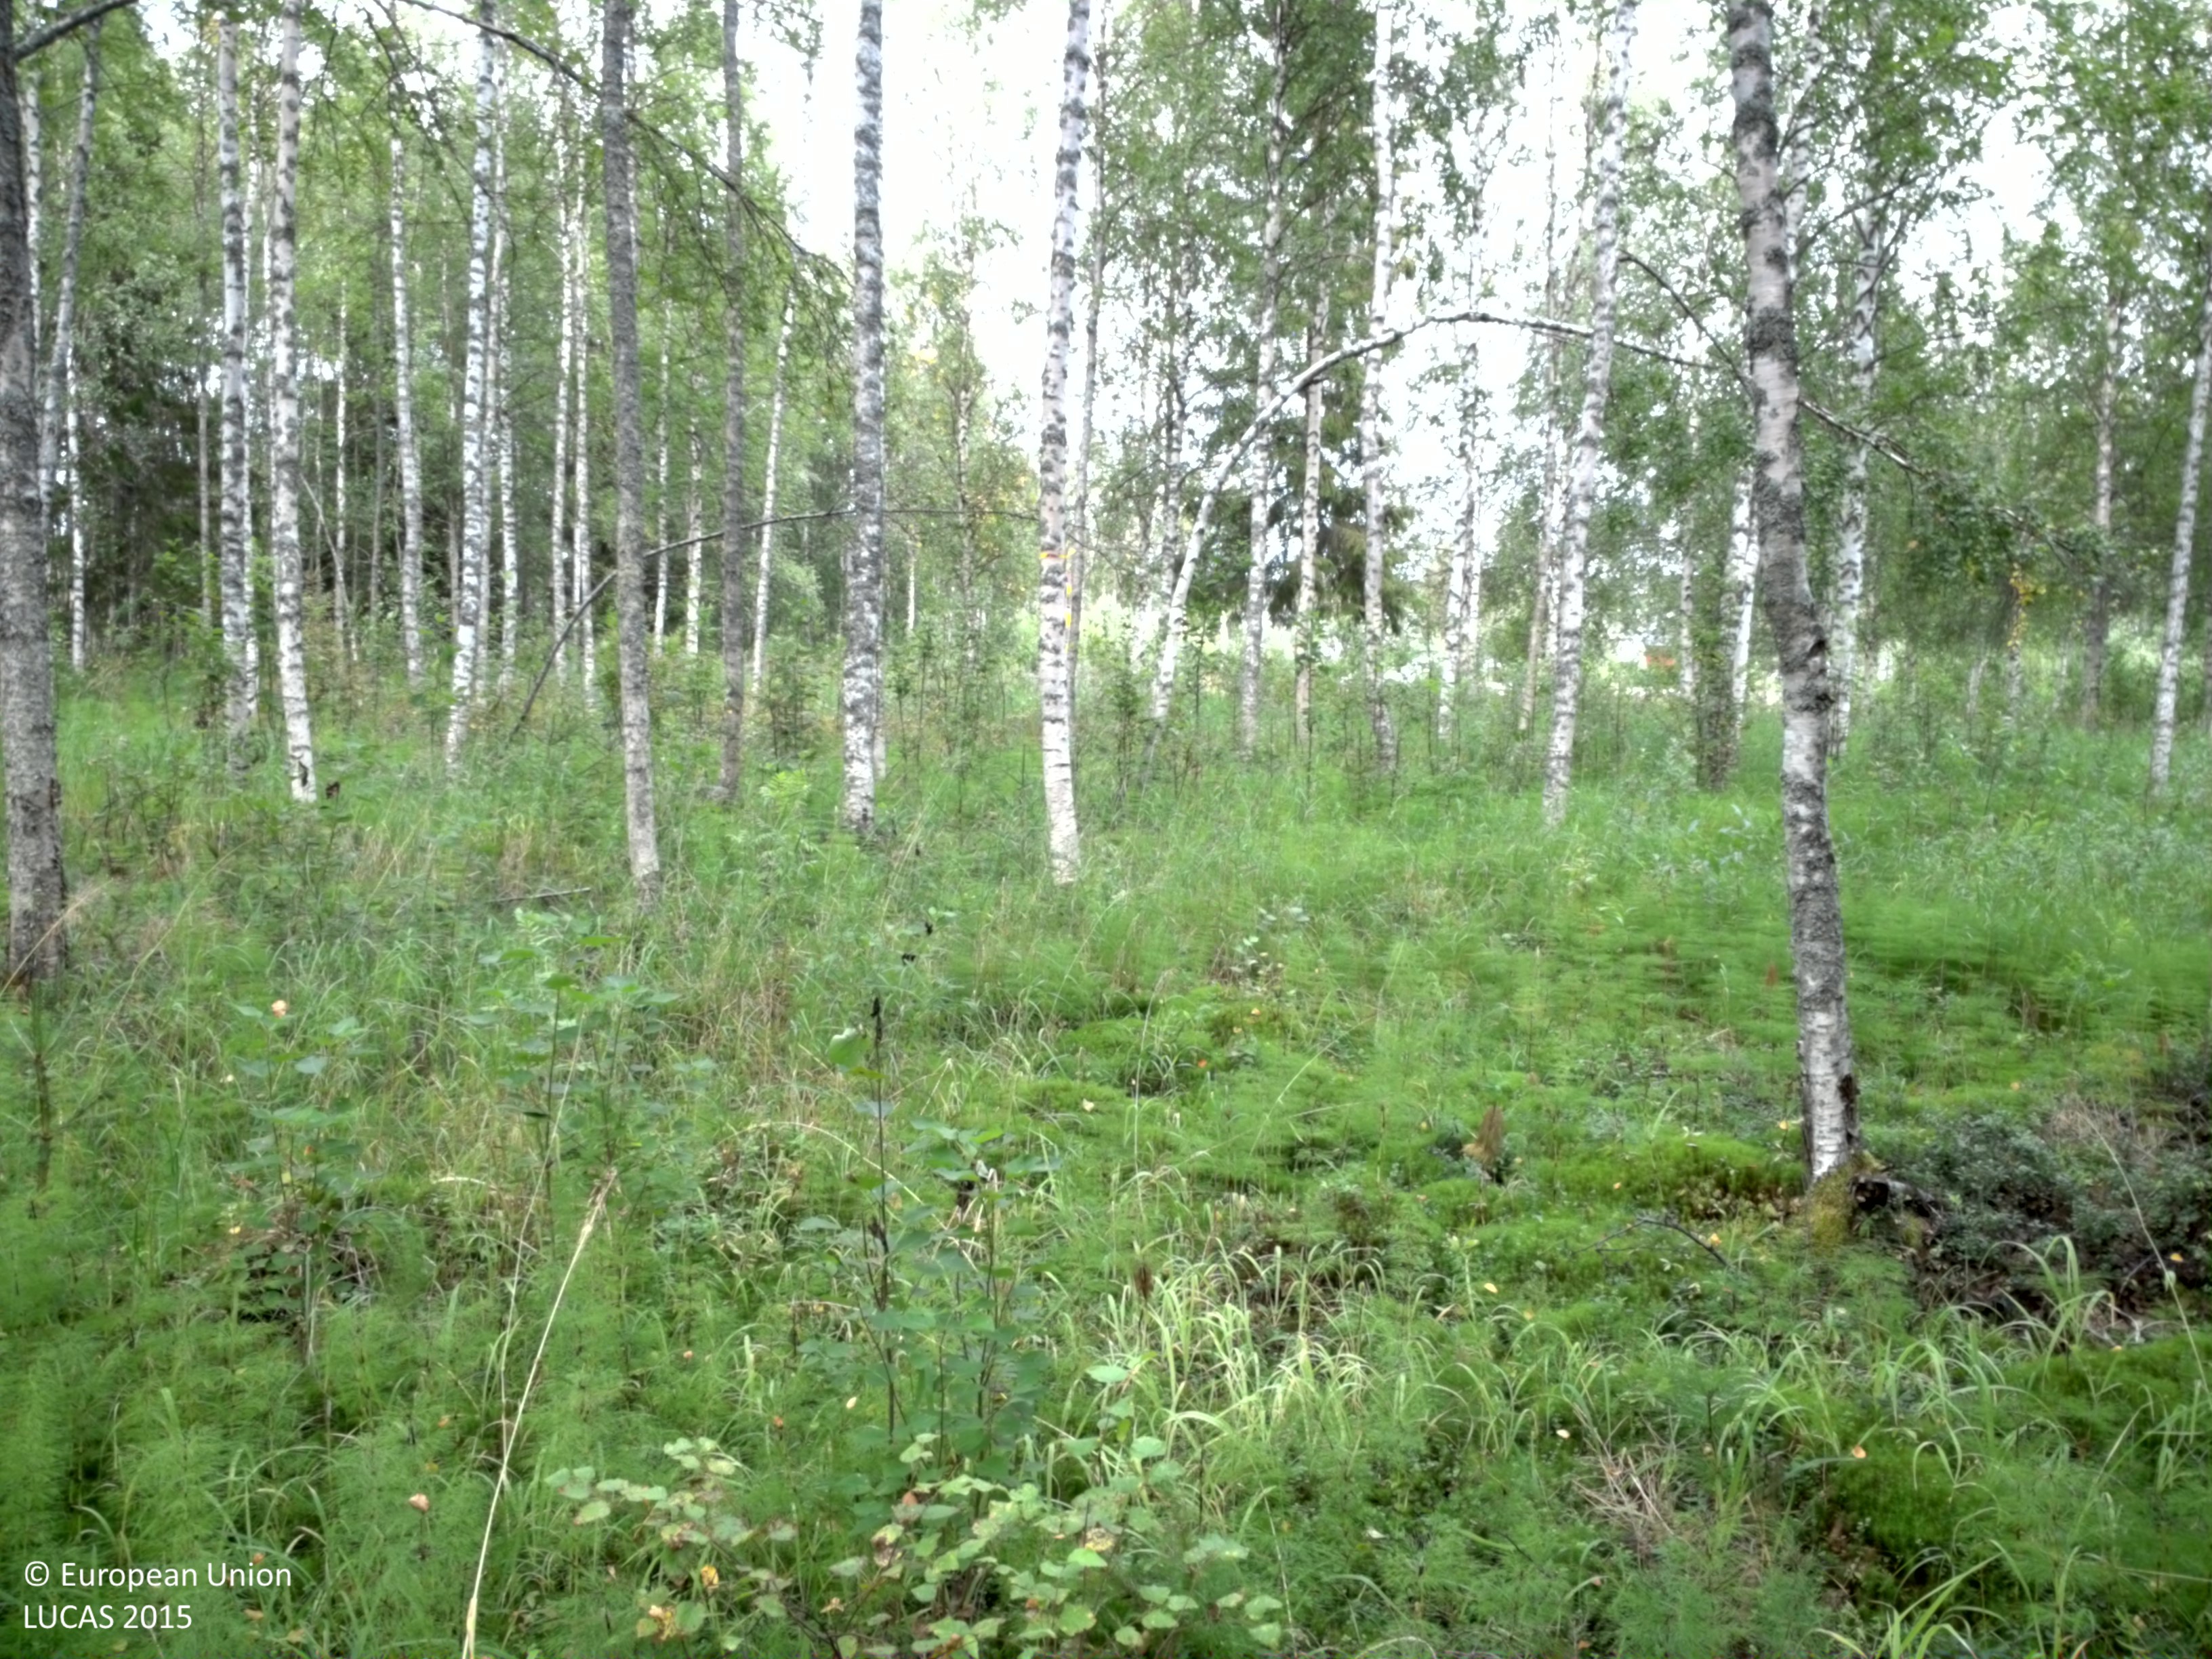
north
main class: Woodland
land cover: Broadleaved woodland
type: non-riverine alder, birch or aspen forest
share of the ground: 25 - 50 %
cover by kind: shrubs 50 %, broadleaved forest trees 40 %, coniferous forest trees 5 %, lichens and mosses 5 %
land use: Forestry
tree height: > 5 m
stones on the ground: < 10 %
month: August
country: SE
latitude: 65.8911
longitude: 22.6405
